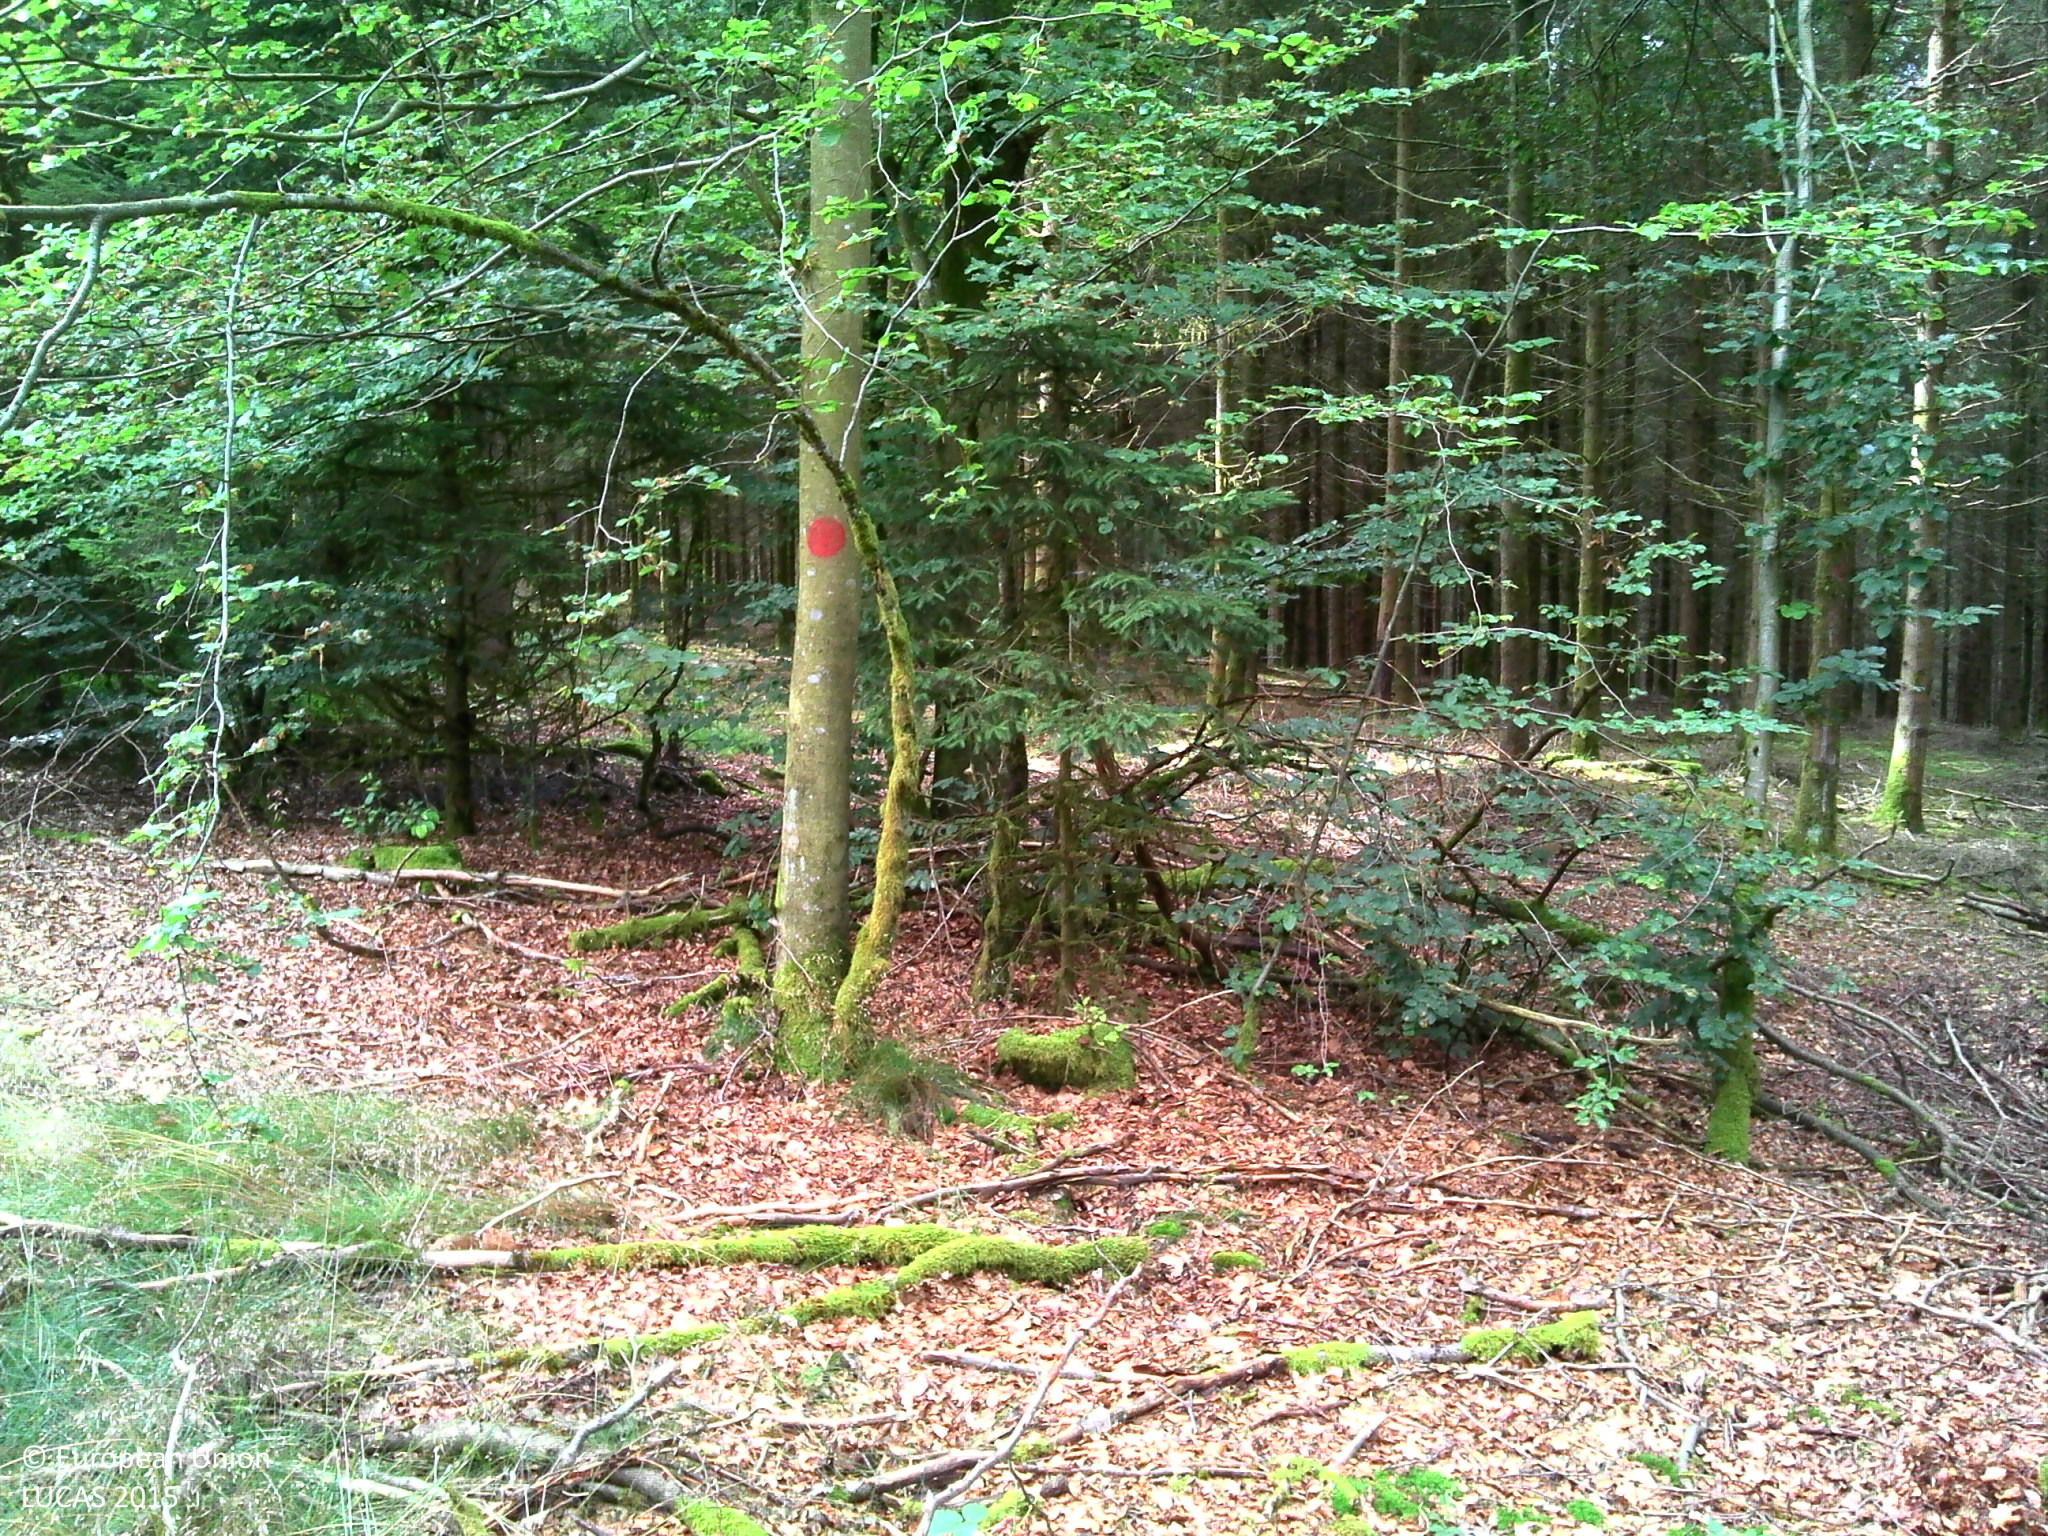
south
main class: Woodland
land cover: Broadleaved woodland
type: beech forest
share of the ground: 50 - 75 %
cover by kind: broadleaved forest trees 50 %, unconsolidated bare surface 25 %, herbaceous plants 20 %, coniferous forest trees 5 %
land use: Forestry
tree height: > 5 m
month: July
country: BE
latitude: 49.7662
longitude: 5.3749
